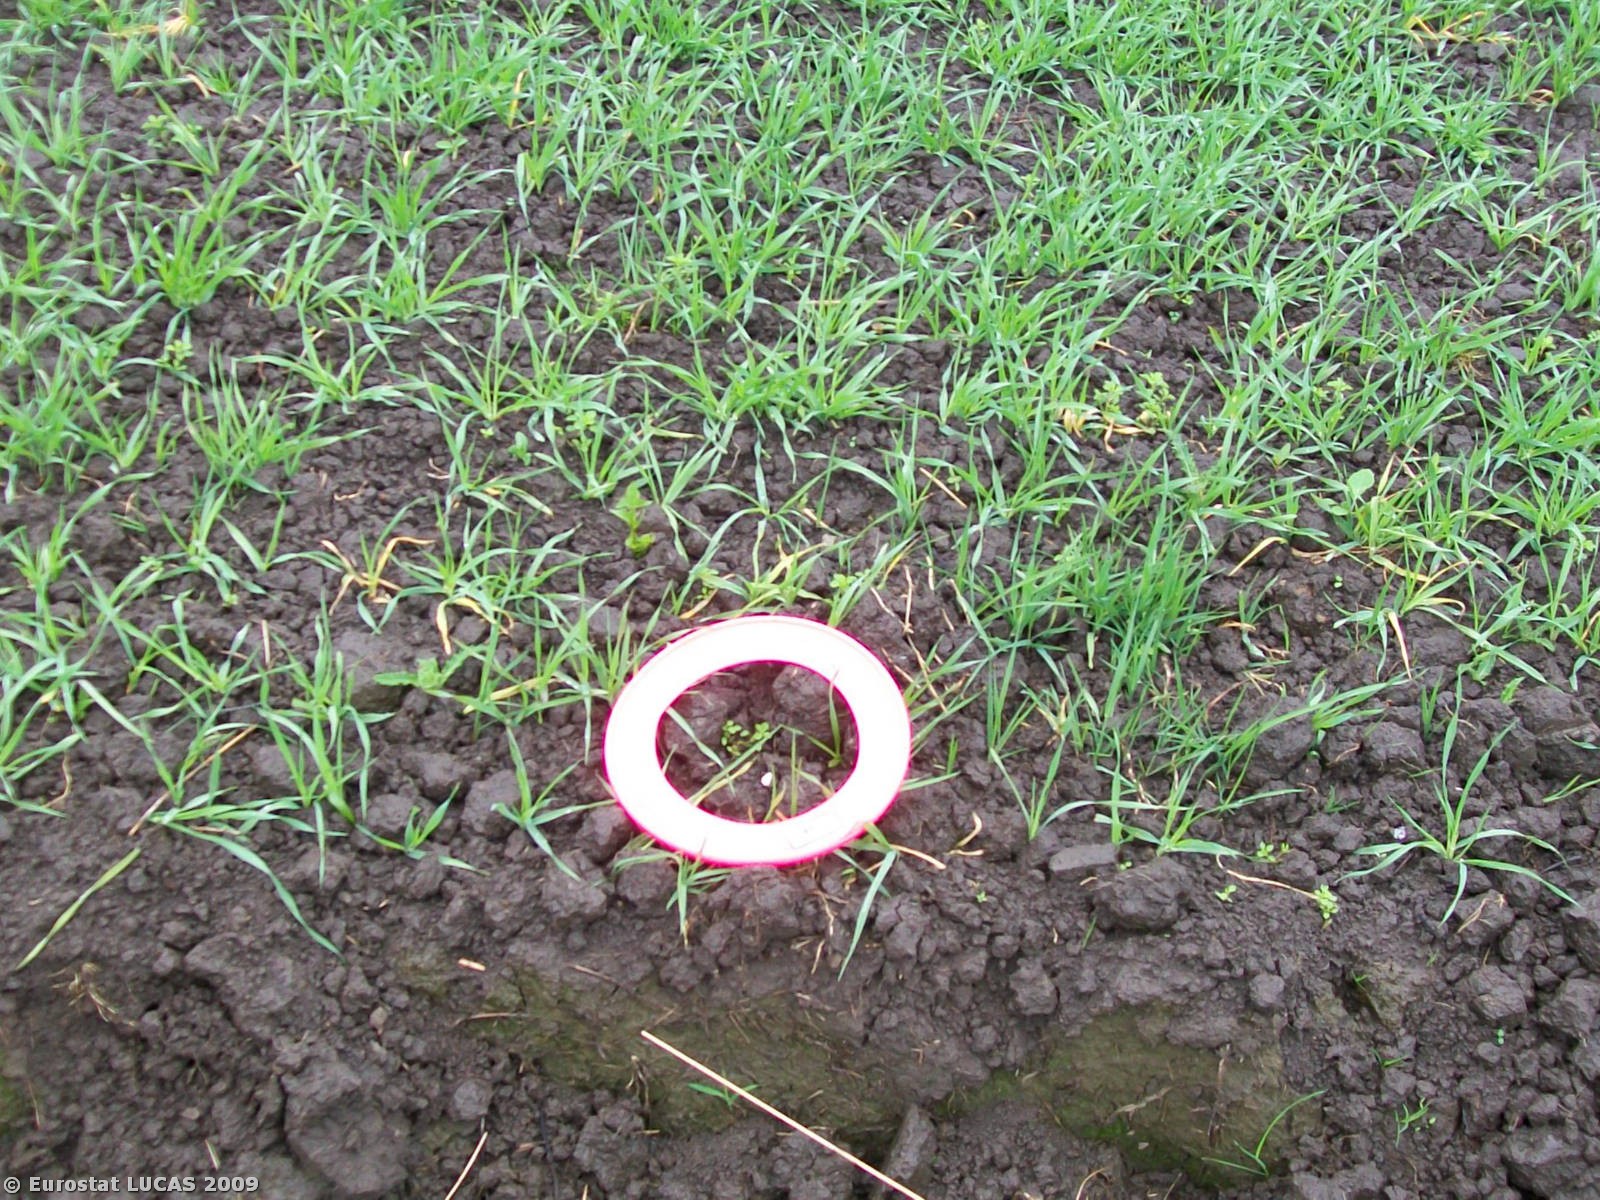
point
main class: Cropland
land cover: Barley
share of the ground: 50 - 75 %
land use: Agriculture (excluding fallow land and kitchen gardens)
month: May
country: GB
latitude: 53.7596
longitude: -2.9508
